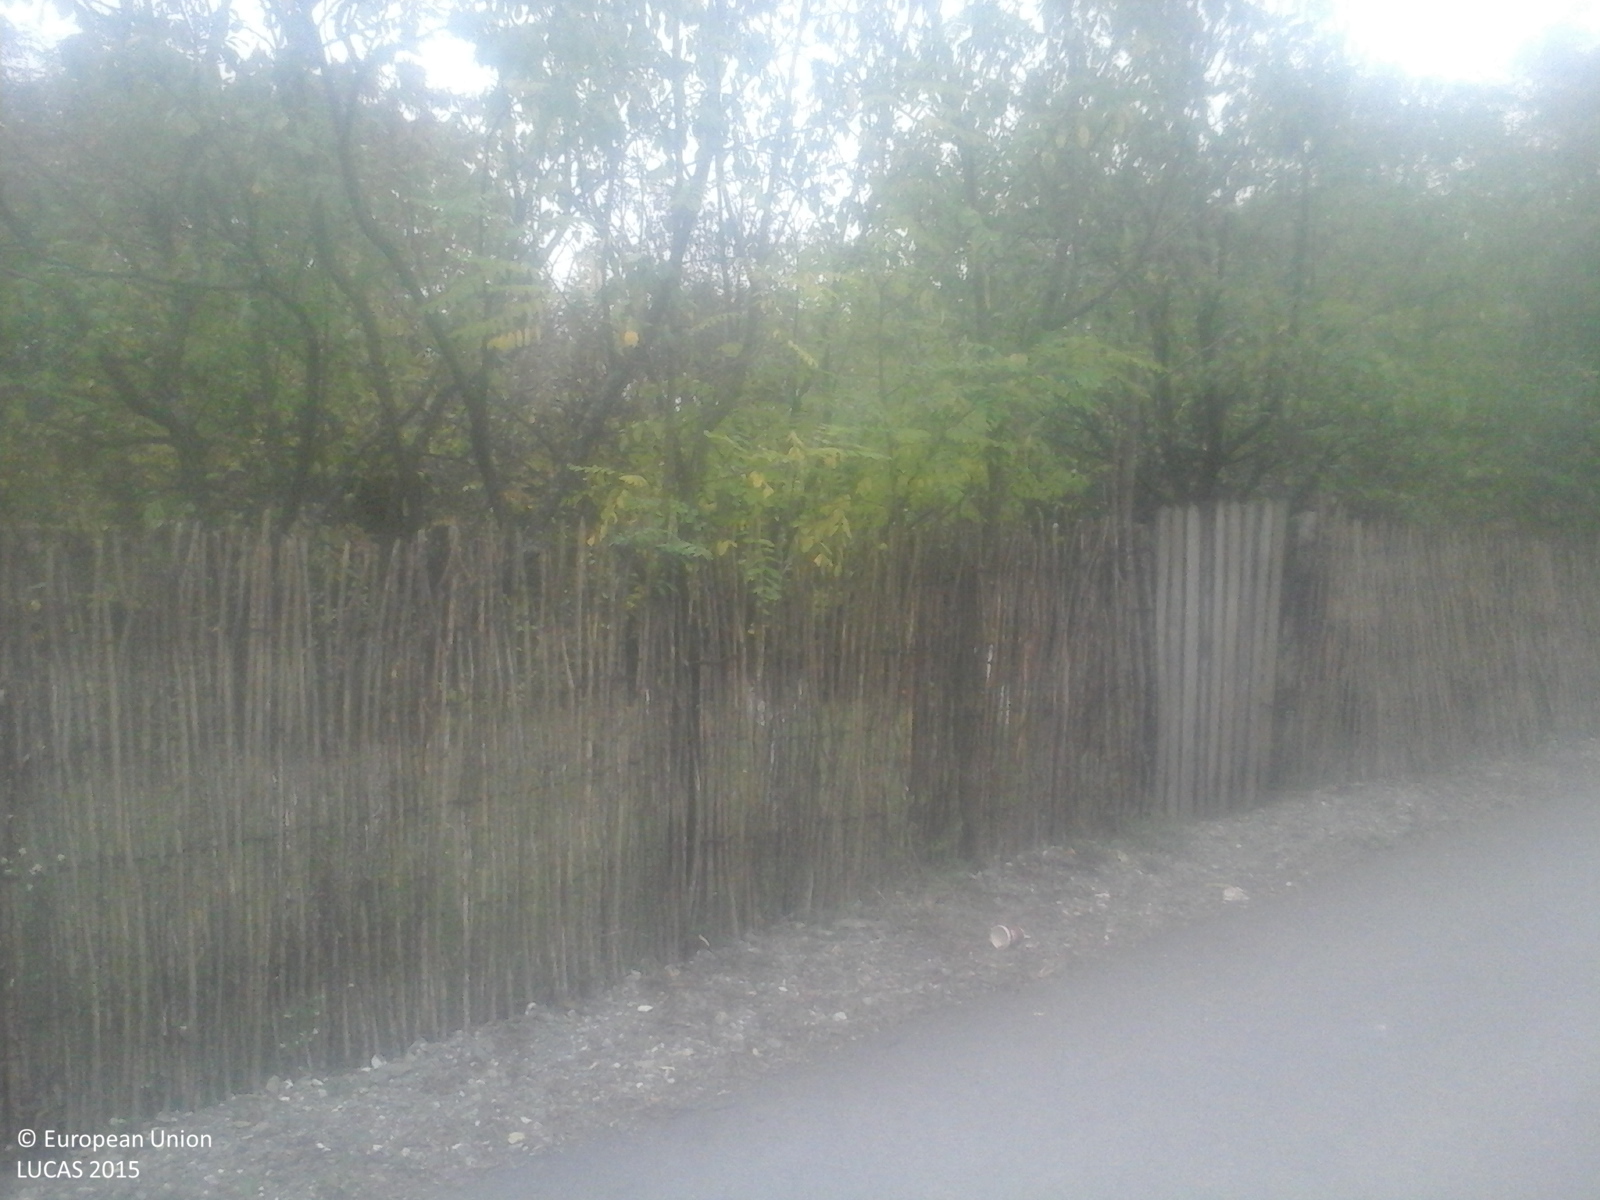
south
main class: Grassland
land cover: Spontaneously vegetated surfaces
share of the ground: > 75 %
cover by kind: herbaceous plants 100 %
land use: Agriculture (excluding fallow land and kitchen gardens)
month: October
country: RO
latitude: 45.0632
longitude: 25.7620
